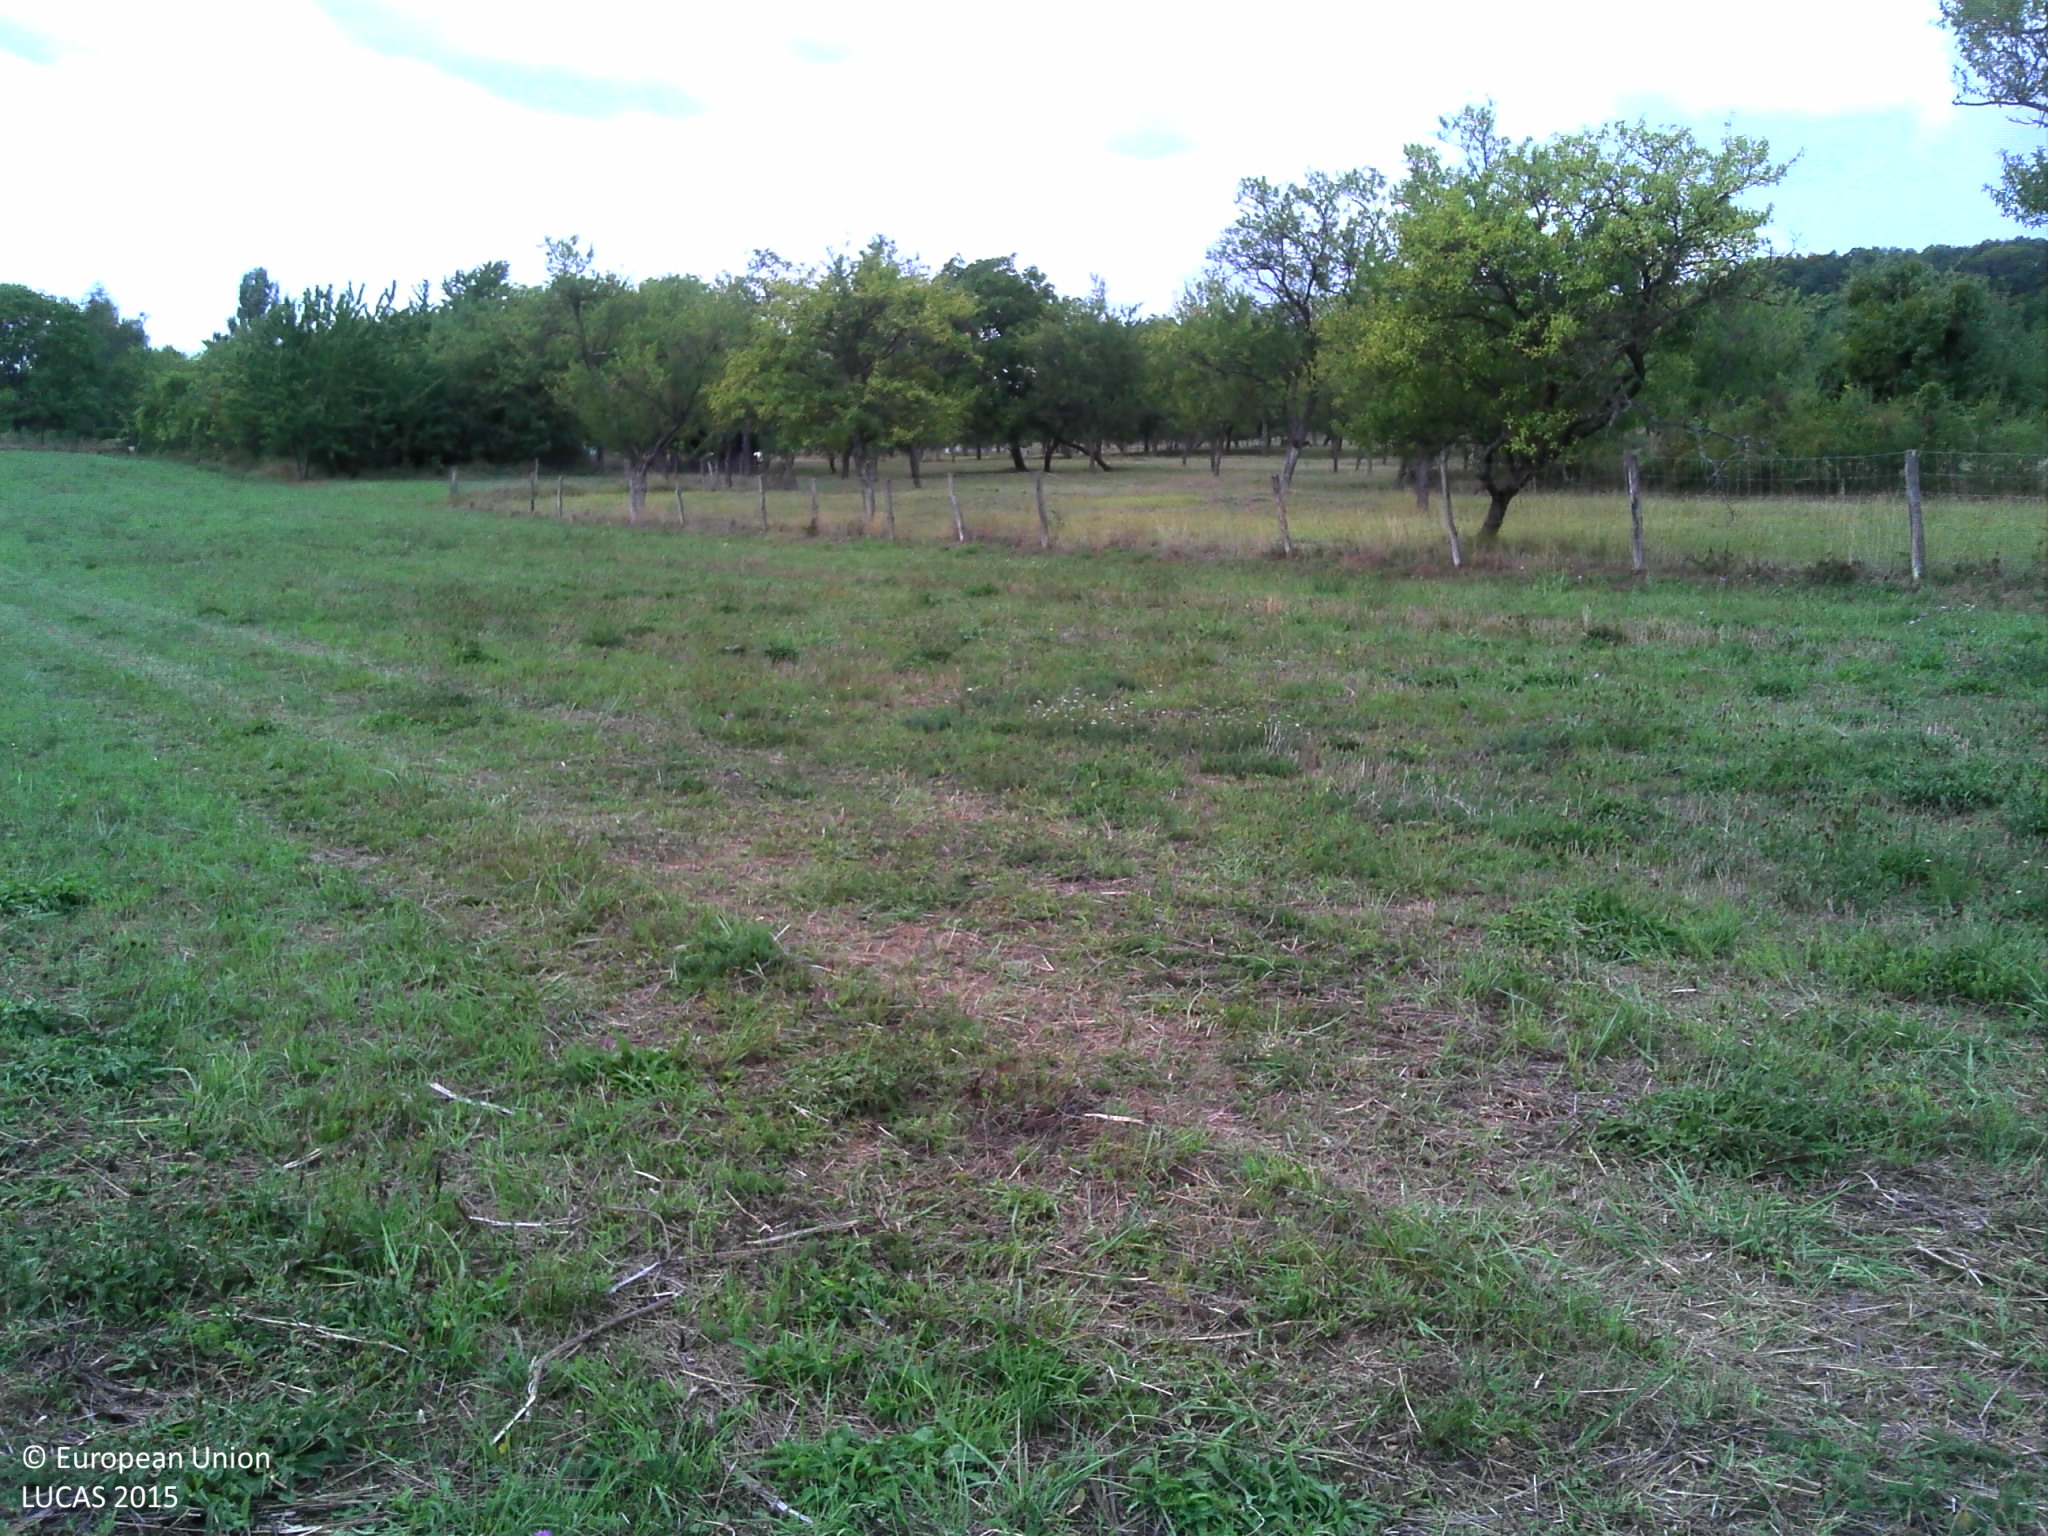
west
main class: Cropland
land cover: Temporary grasslands
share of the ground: > 75 %
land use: Agriculture (excluding fallow land and kitchen gardens)
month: September
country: FR
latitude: 48.5853
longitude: 6.0550
